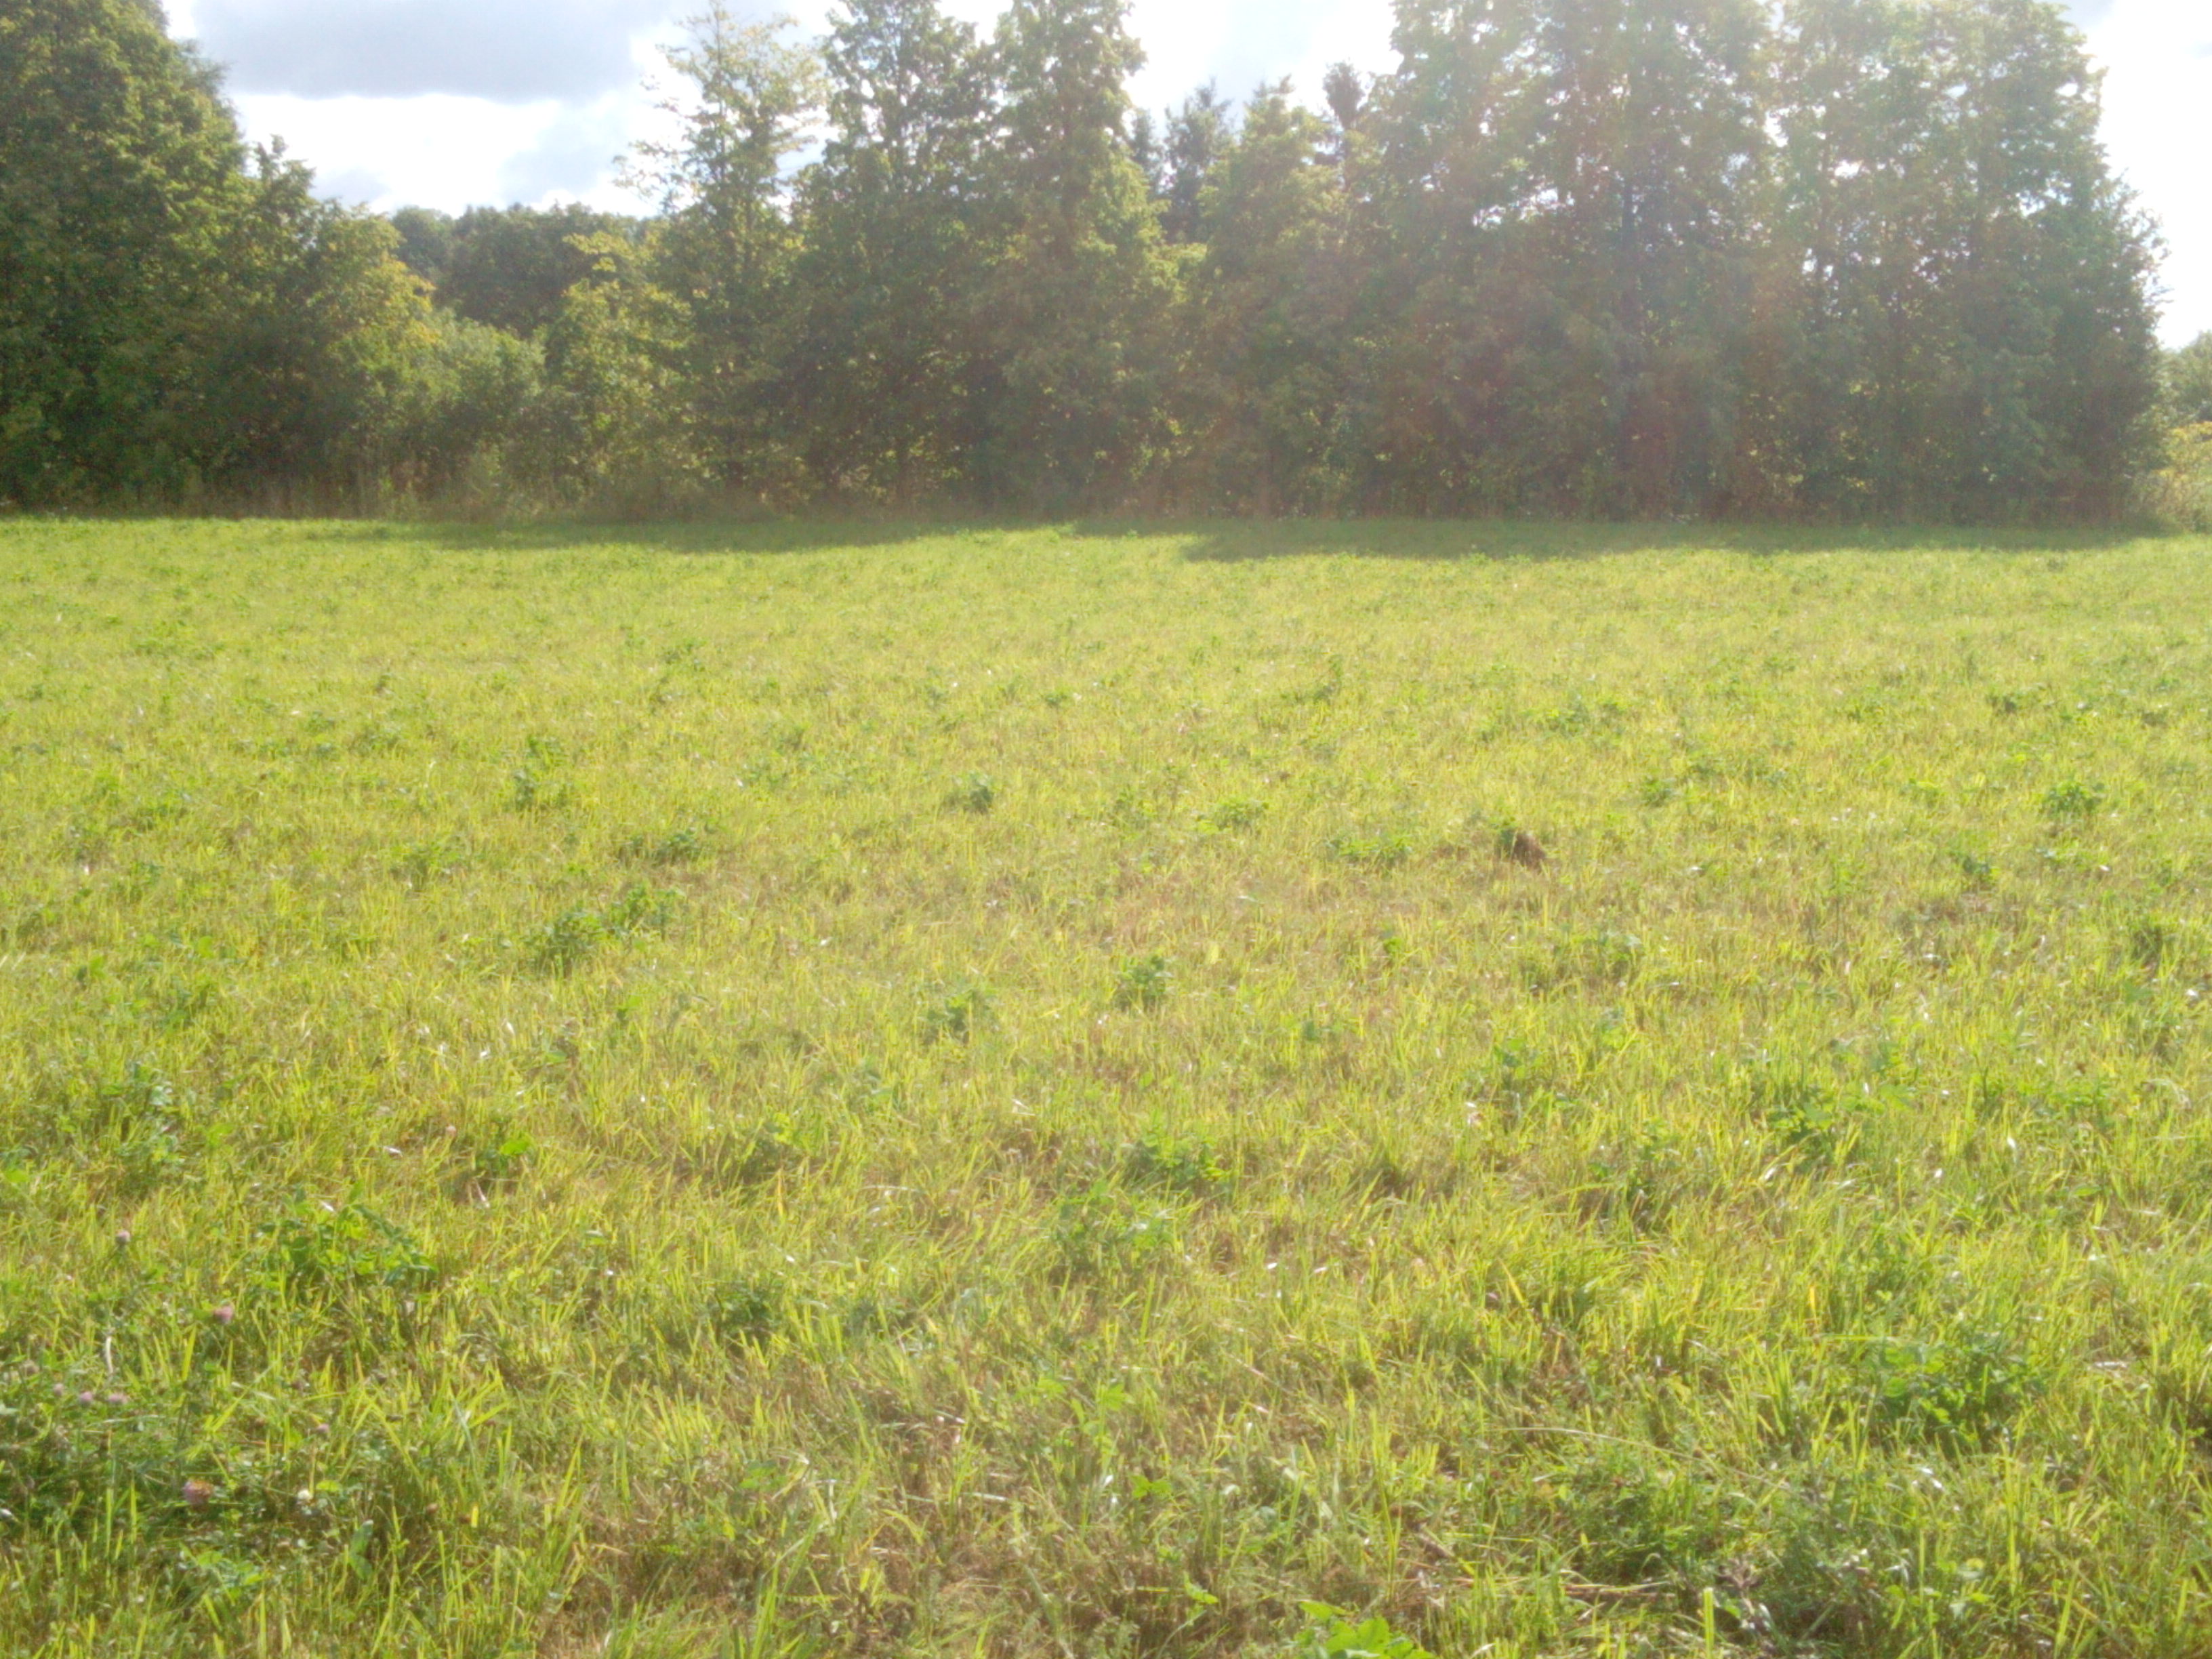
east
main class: Grassland
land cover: Grassland without tree/shrub cover
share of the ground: > 75 %
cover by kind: herbaceous plants 100 %
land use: Agriculture (excluding fallow land and kitchen gardens)
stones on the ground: < 10 %
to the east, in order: Grassland without tree/shrub cover; Broadleaved woodland; Grassland without tree/shrub cover; Potatoes; Artificial constructions in urban areas; Apple fruit; Fences; Apple fruit; Grassland without tree/shrub cover; Broadleaved woodland
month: August
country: LV
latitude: 56.4900
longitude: 21.2616
